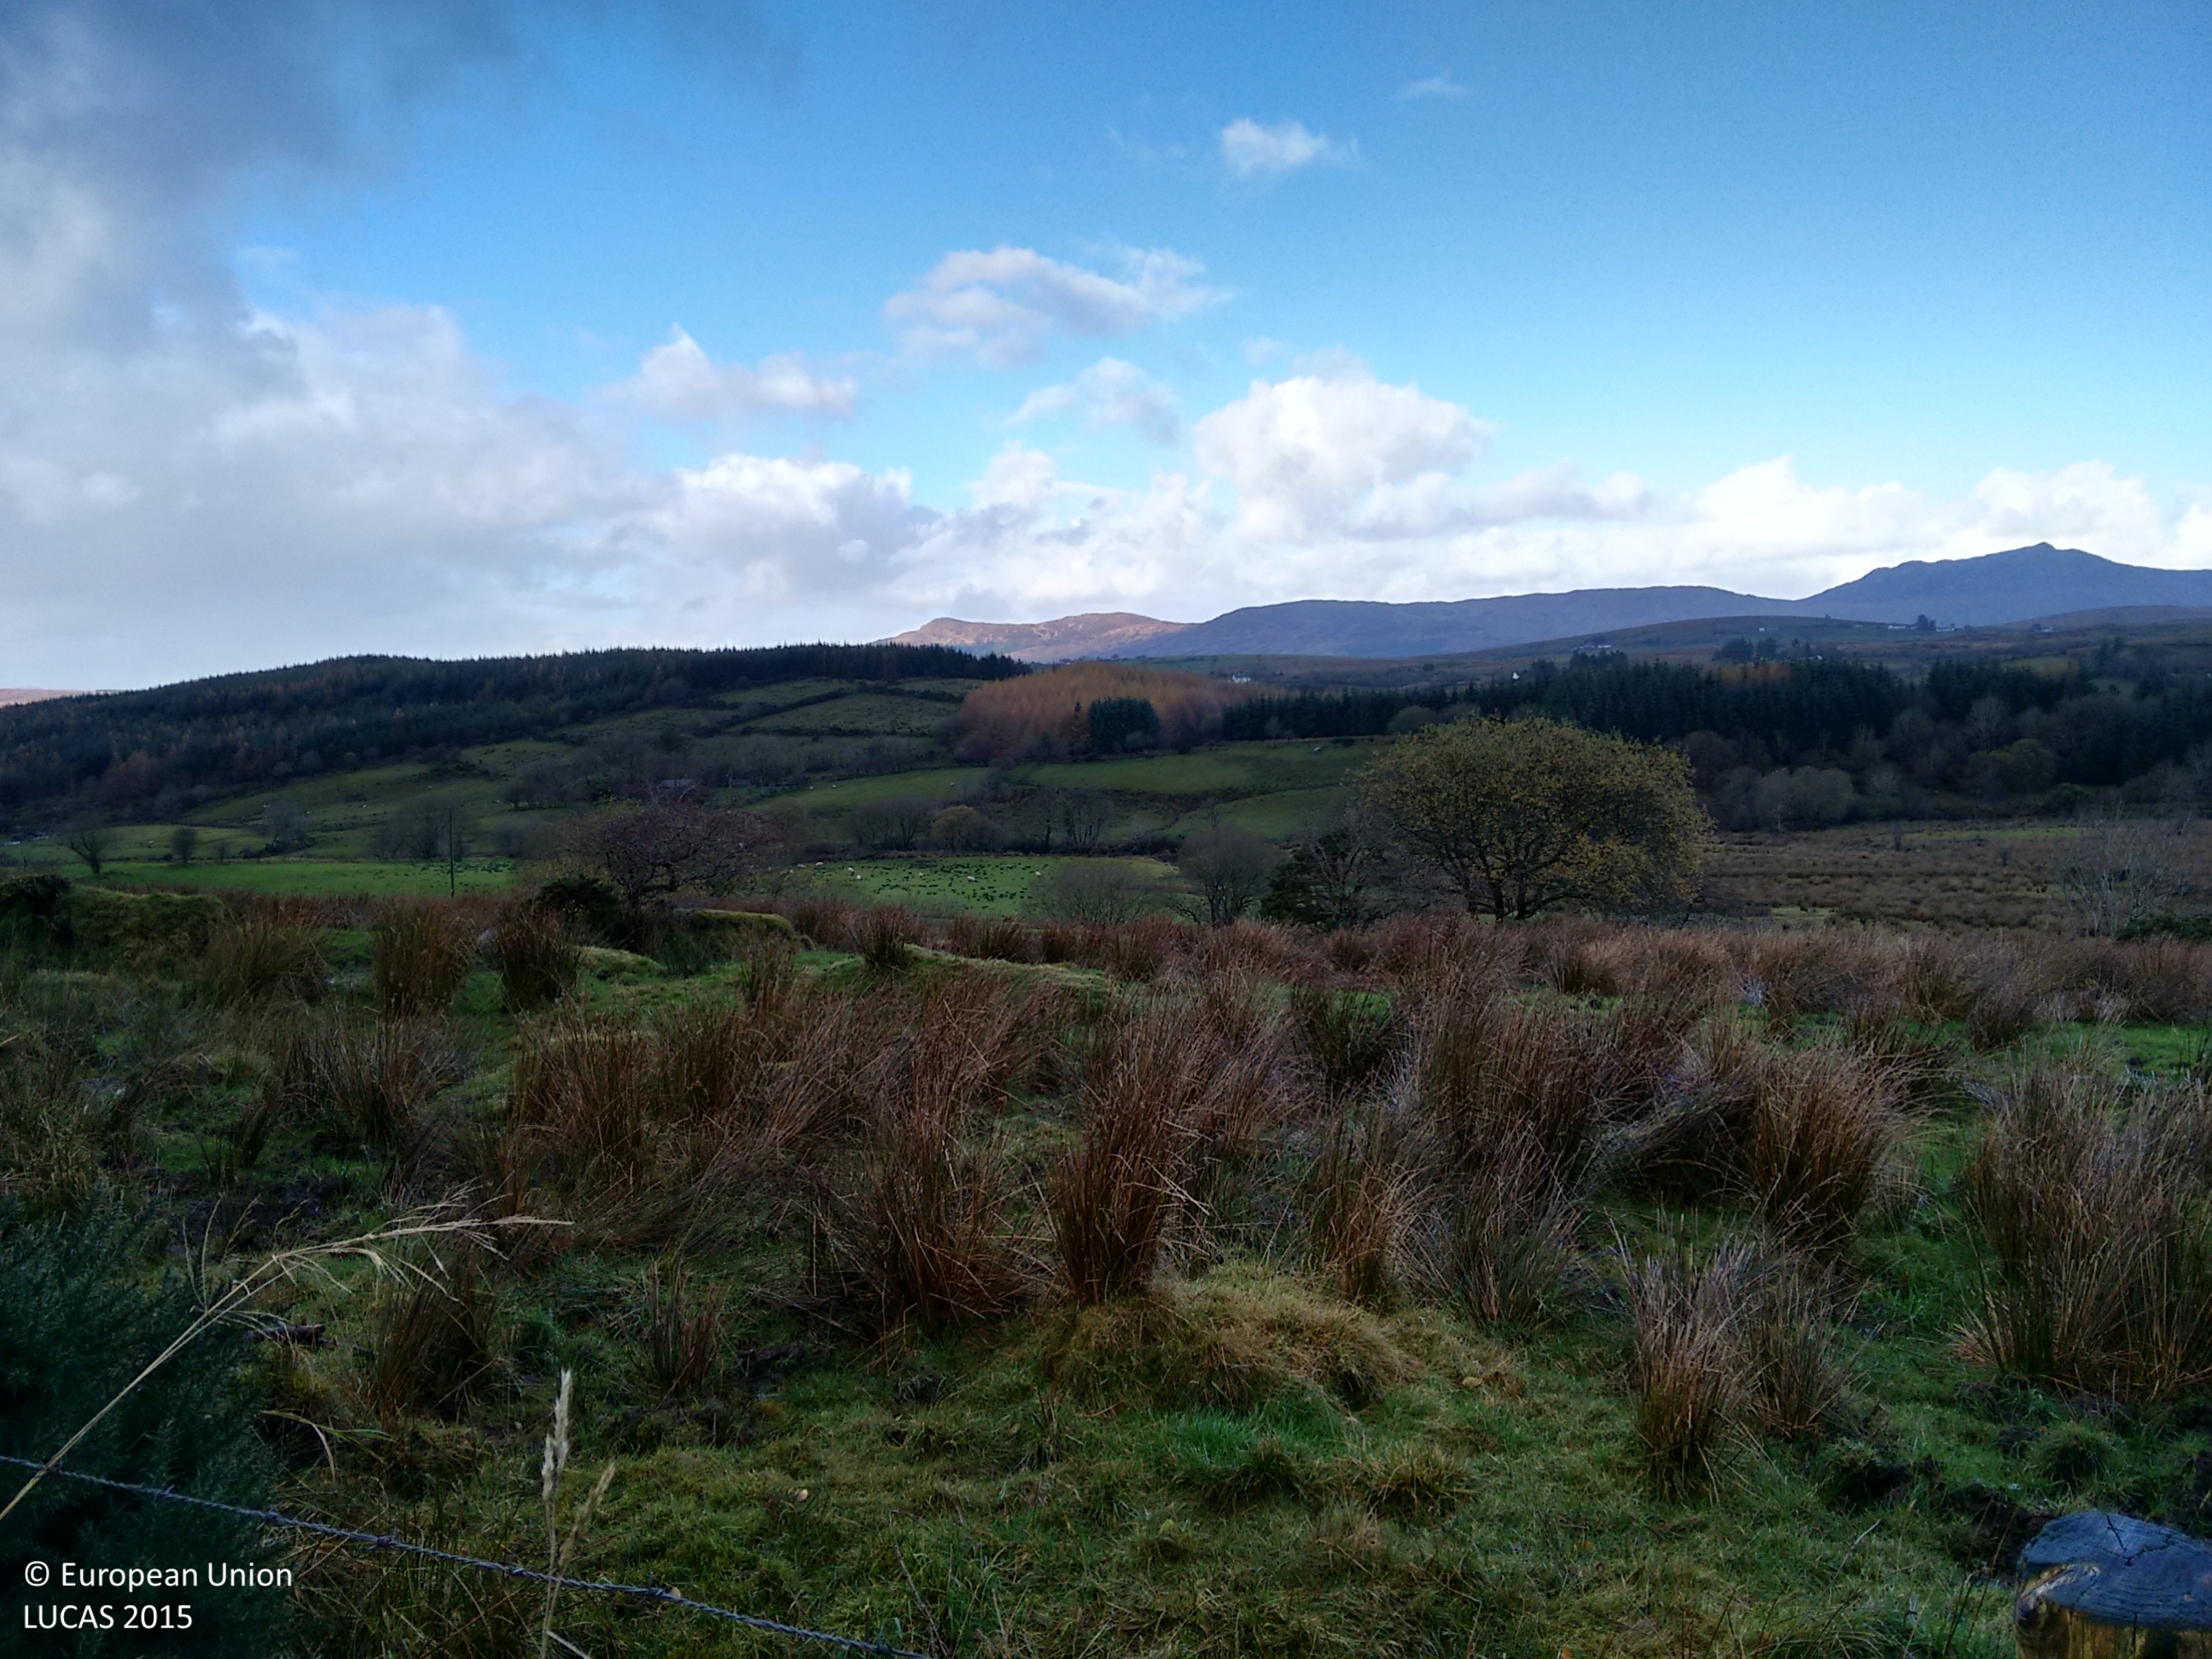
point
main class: Grassland
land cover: Grassland without tree/shrub cover
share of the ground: > 75 %
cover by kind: herbaceous plants 100 %
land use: Agriculture (excluding fallow land and kitchen gardens)
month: November
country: IE
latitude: 54.6899
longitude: -8.1581
